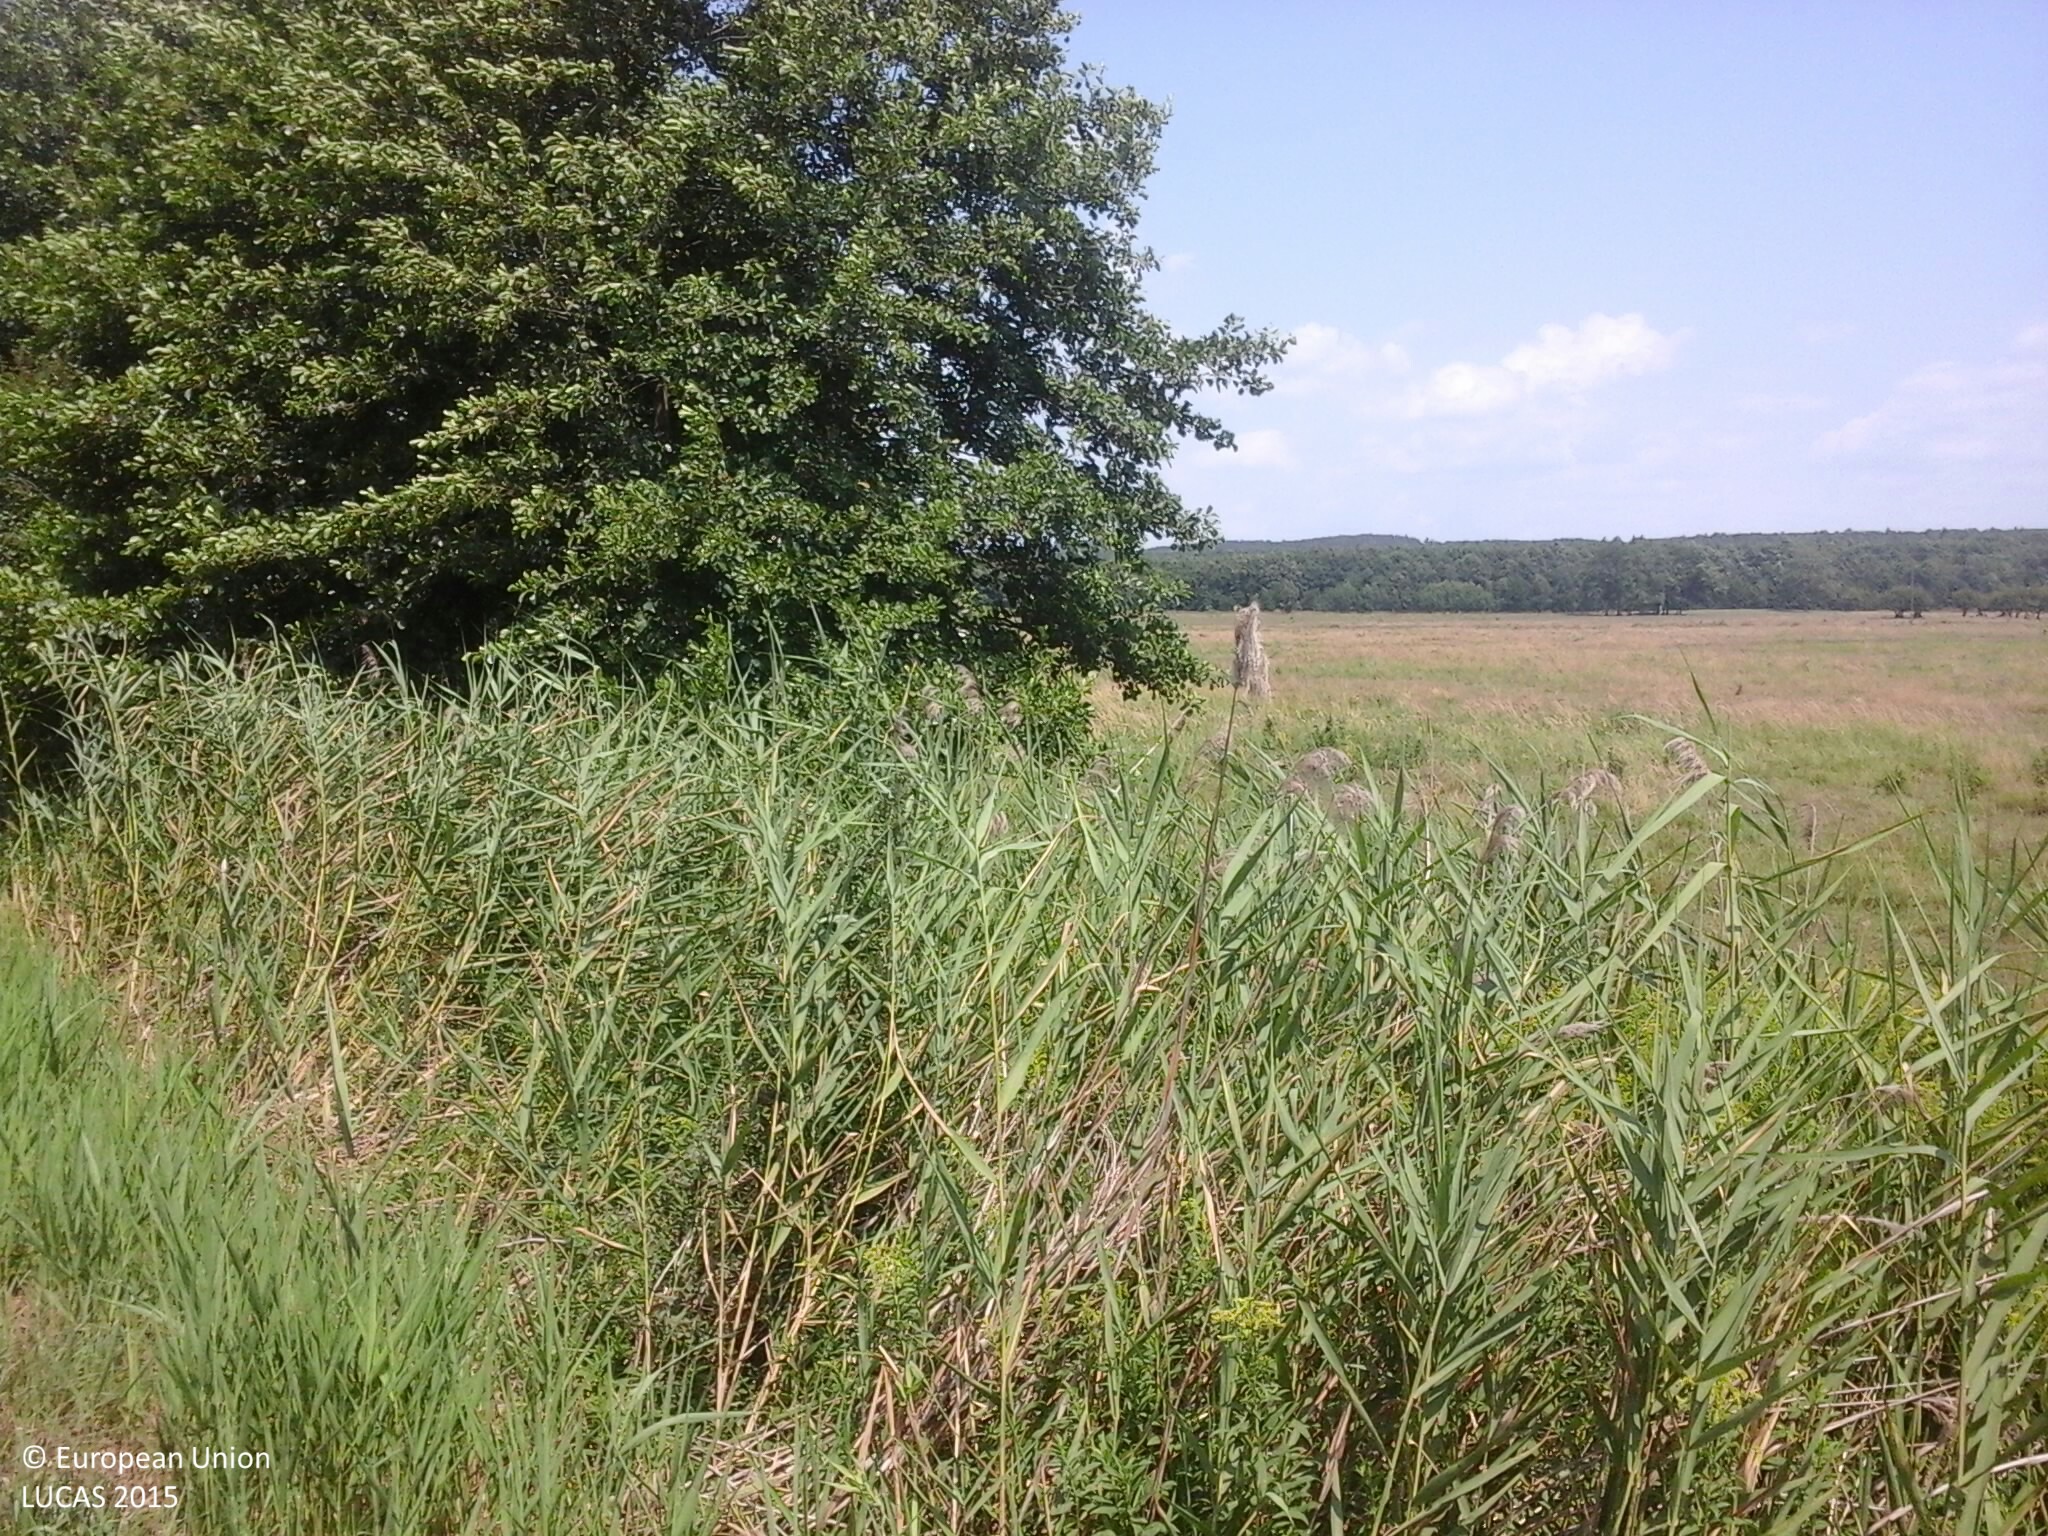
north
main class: Grassland
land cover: Grassland without tree/shrub cover
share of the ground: > 75 %
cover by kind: herbaceous plants 100 %
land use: Agriculture (excluding fallow land and kitchen gardens)
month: July
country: HU
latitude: 46.8745
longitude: 17.3661
